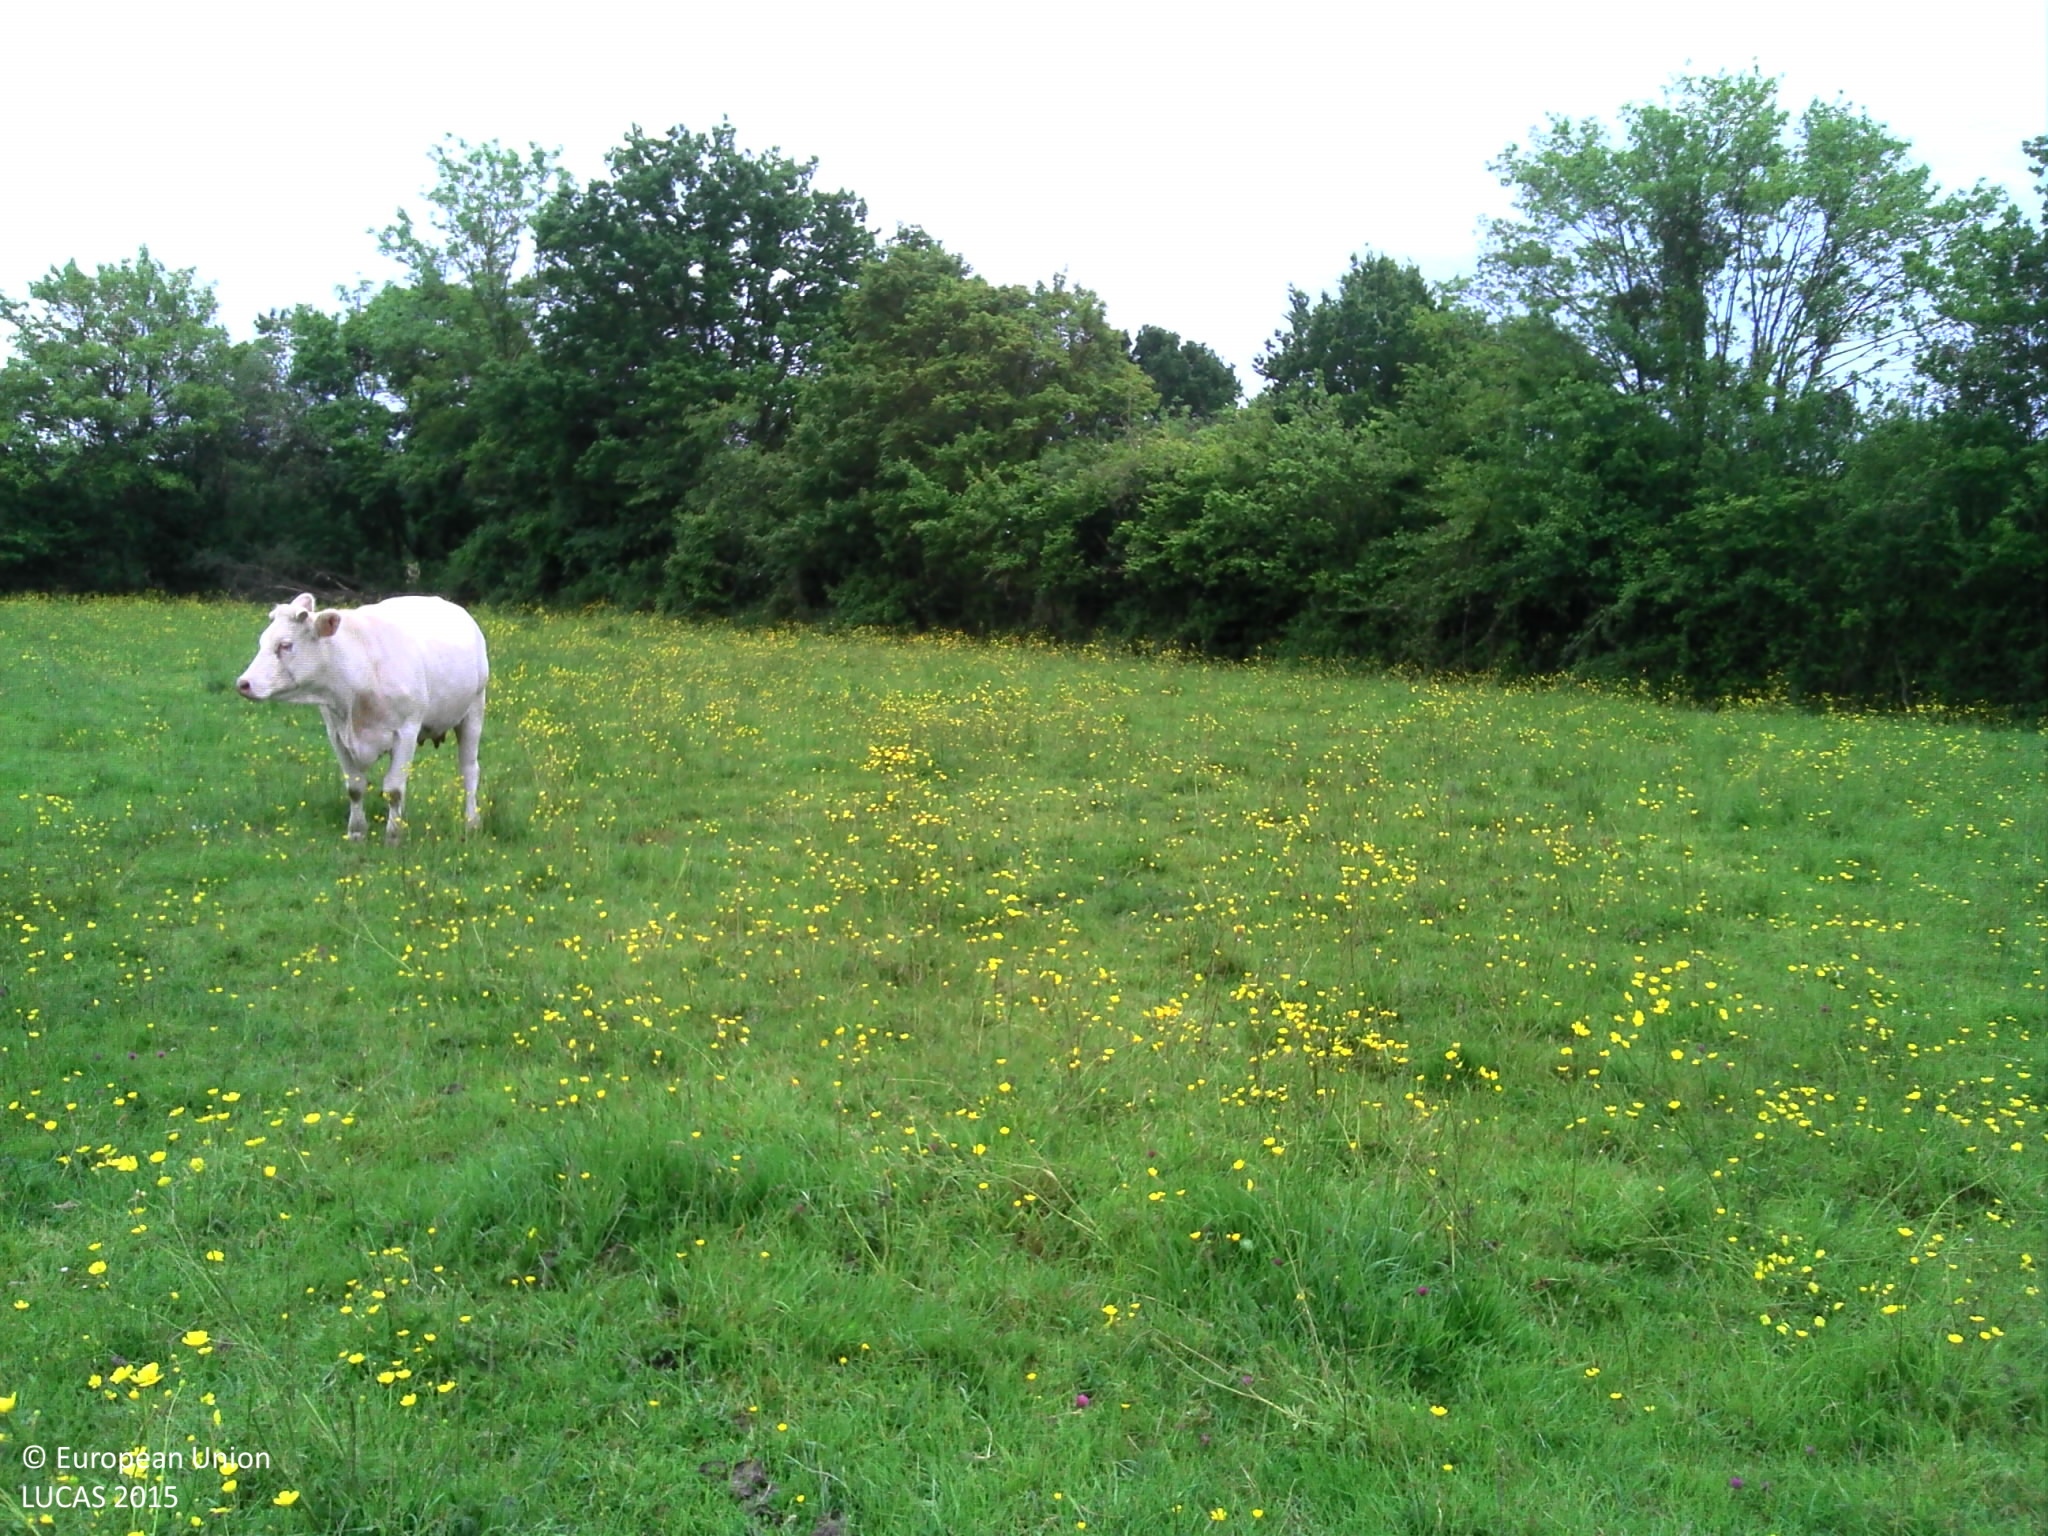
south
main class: Grassland
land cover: Grassland without tree/shrub cover
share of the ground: > 75 %
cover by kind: herbaceous plants 100 %
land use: Agriculture (excluding fallow land and kitchen gardens)
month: May
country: FR
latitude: 49.3156
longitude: 0.0788
